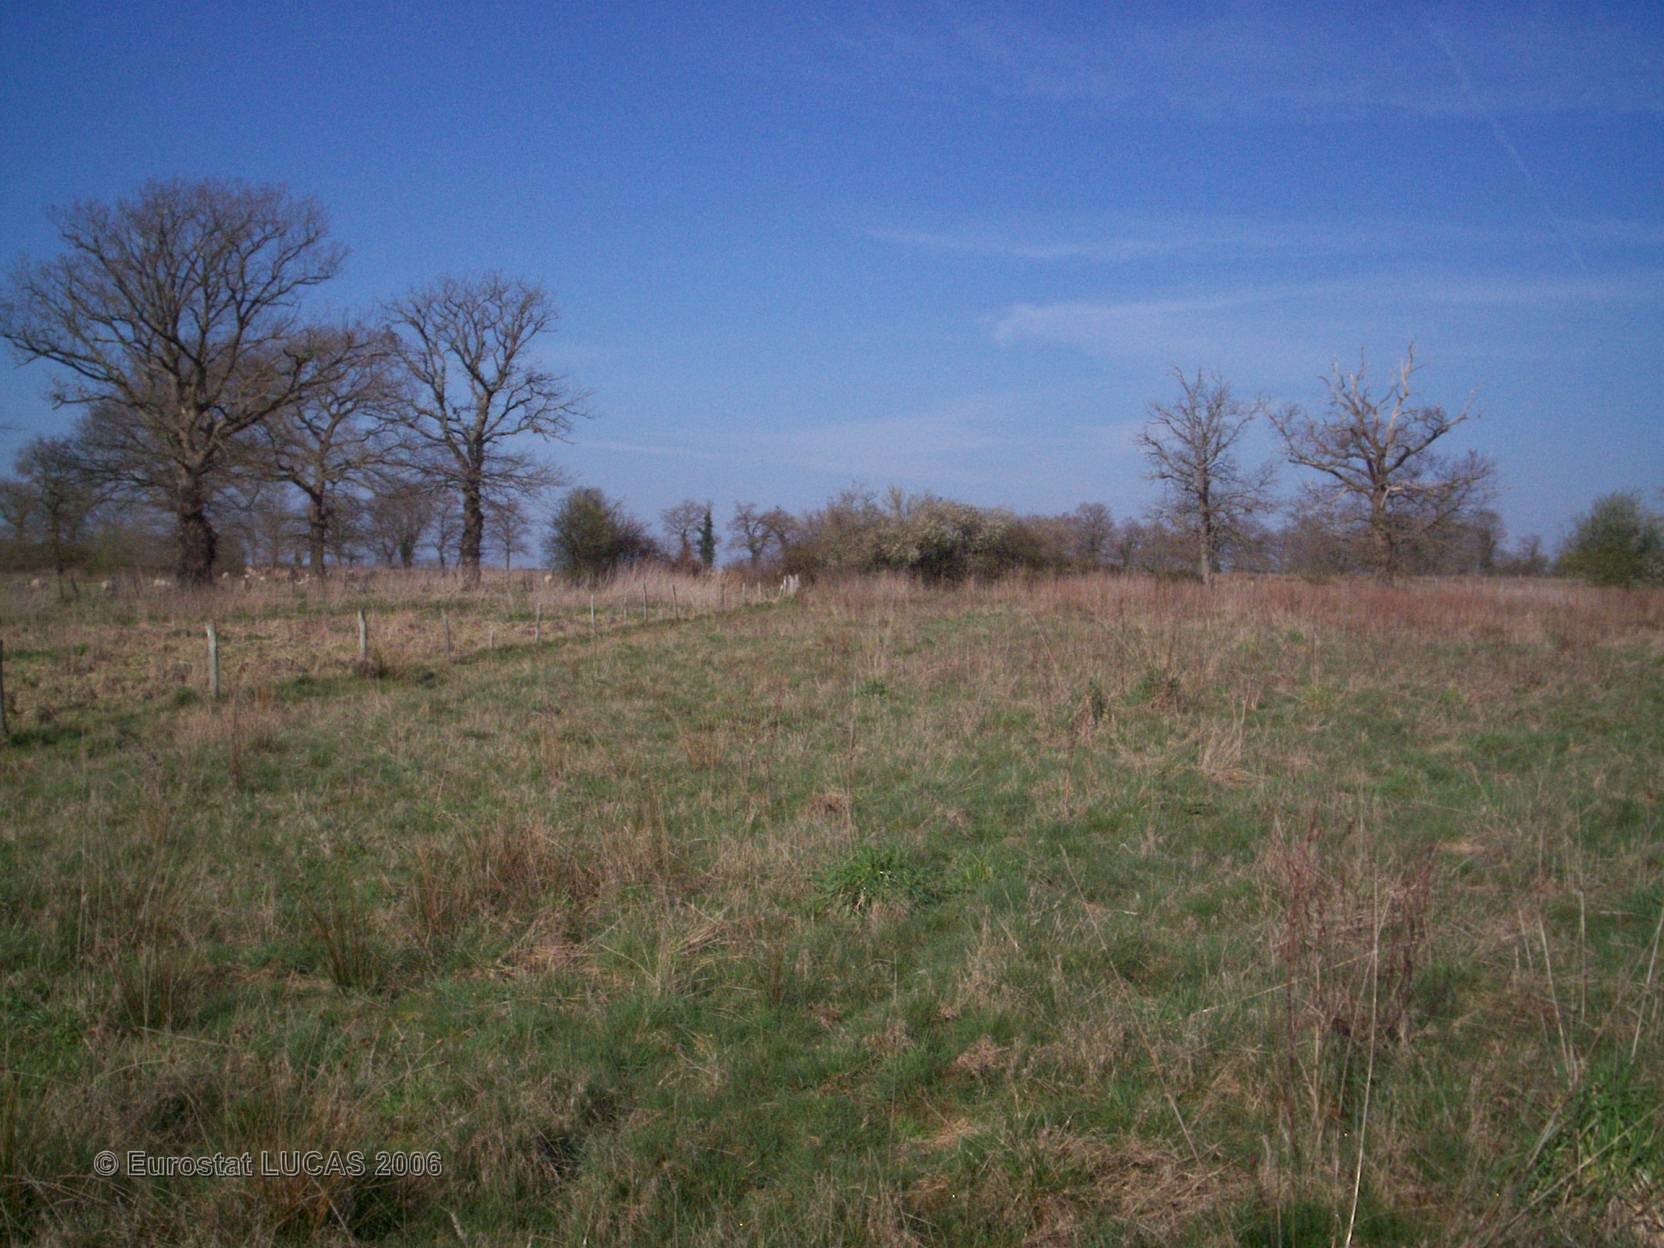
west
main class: Grassland
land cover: Grassland without tree/shrub cover
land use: Agriculture (excluding fallow land and kitchen gardens)
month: April
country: FR
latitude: 46.3430
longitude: 1.1136
